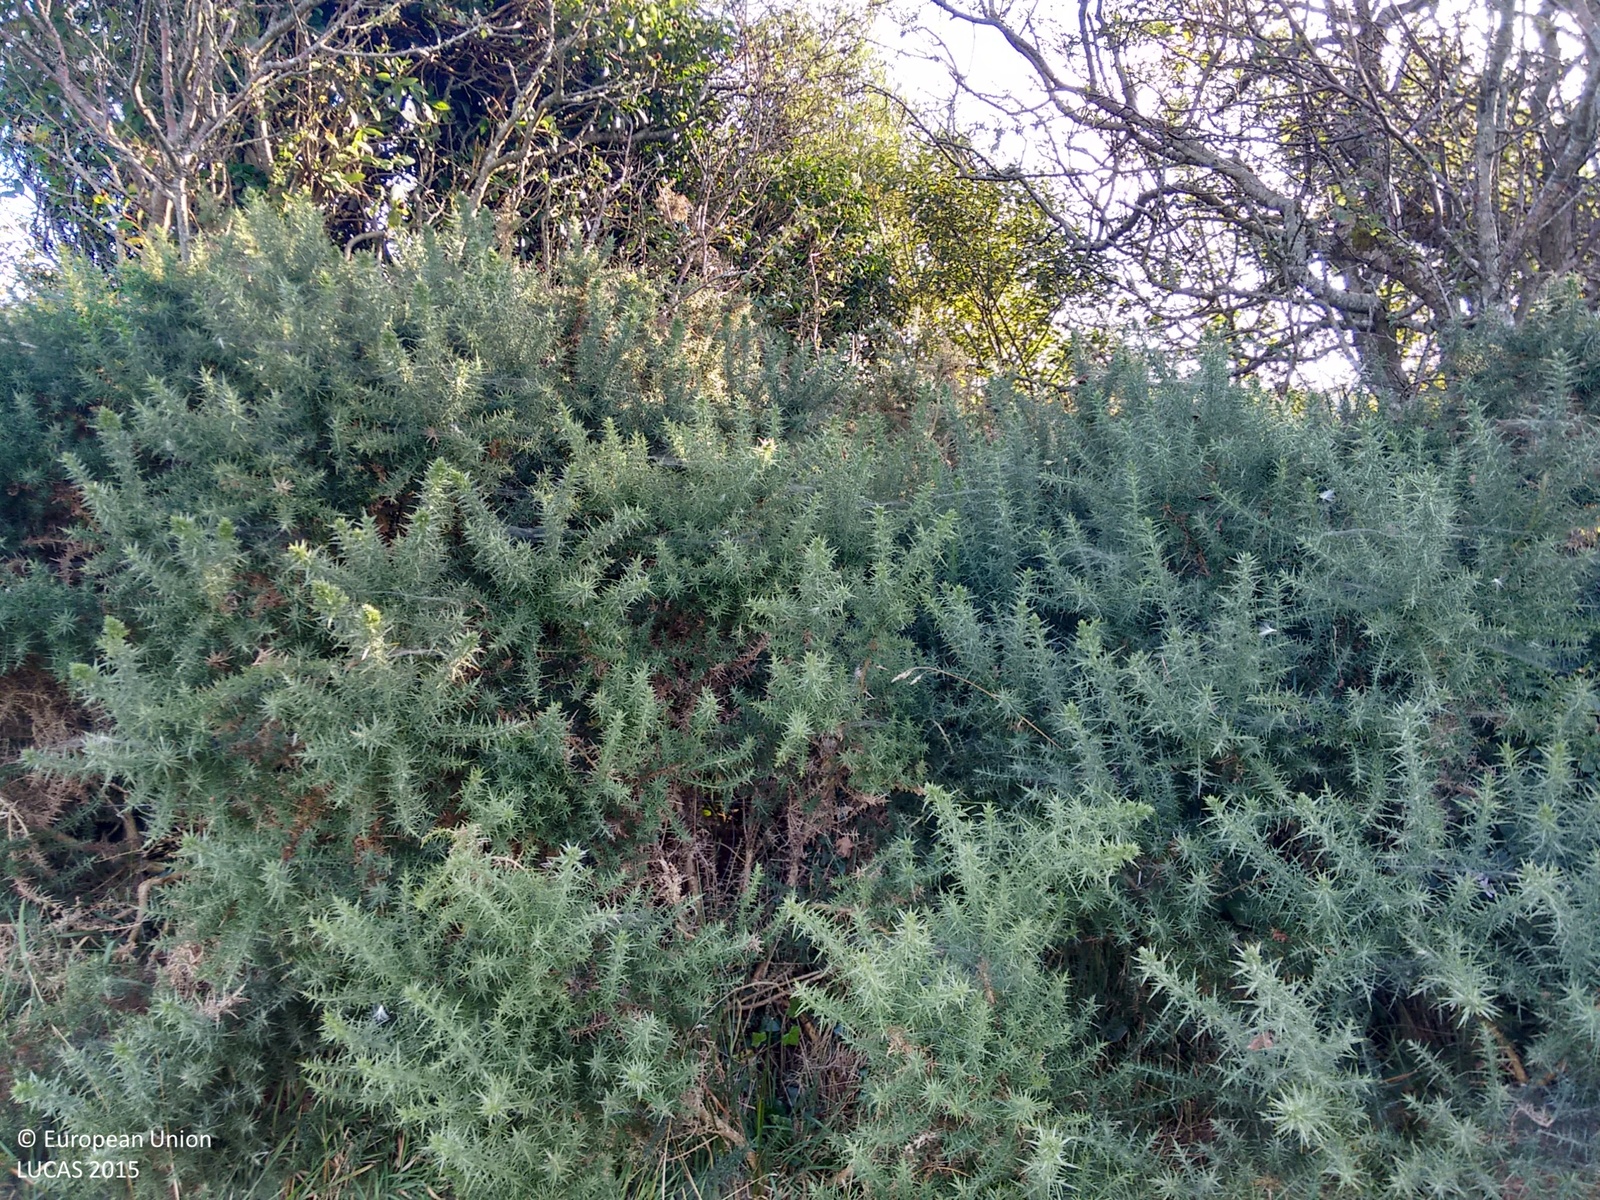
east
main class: Grassland
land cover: Grassland without tree/shrub cover
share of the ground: > 75 %
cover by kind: herbaceous plants 100 %
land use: Agriculture (excluding fallow land and kitchen gardens)
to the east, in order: Grassland without tree/shrub cover; Abandoned hedges; Fences; Broadleaved woodland; Other bare soil; Broadleaved woodland; Grassland without tree/shrub cover; Broadleaved woodland; Shrubland with sparse tree cover
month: September
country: IE
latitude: 55.1728
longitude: -7.7627
